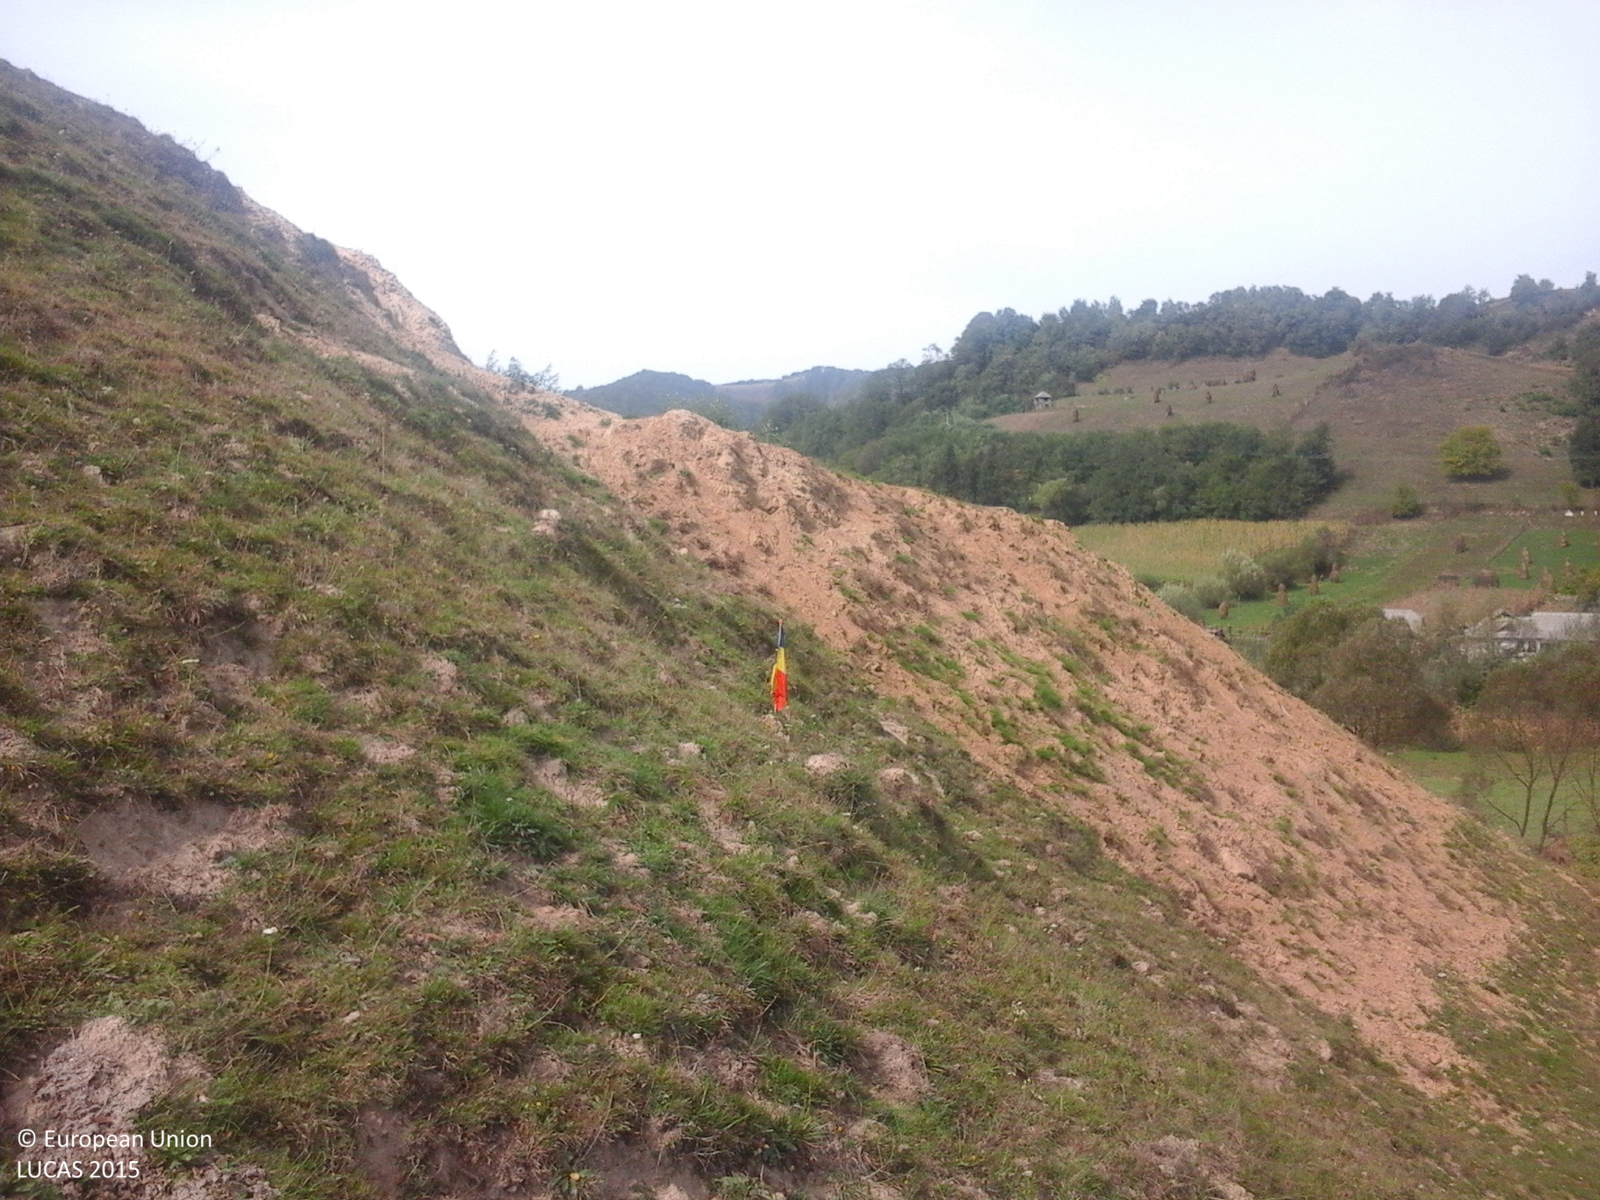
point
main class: Grassland
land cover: Grassland without tree/shrub cover
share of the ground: > 75 %
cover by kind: herbaceous plants 100 %
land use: Agriculture (excluding fallow land and kitchen gardens)
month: September
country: RO
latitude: 47.3972
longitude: 24.1431
